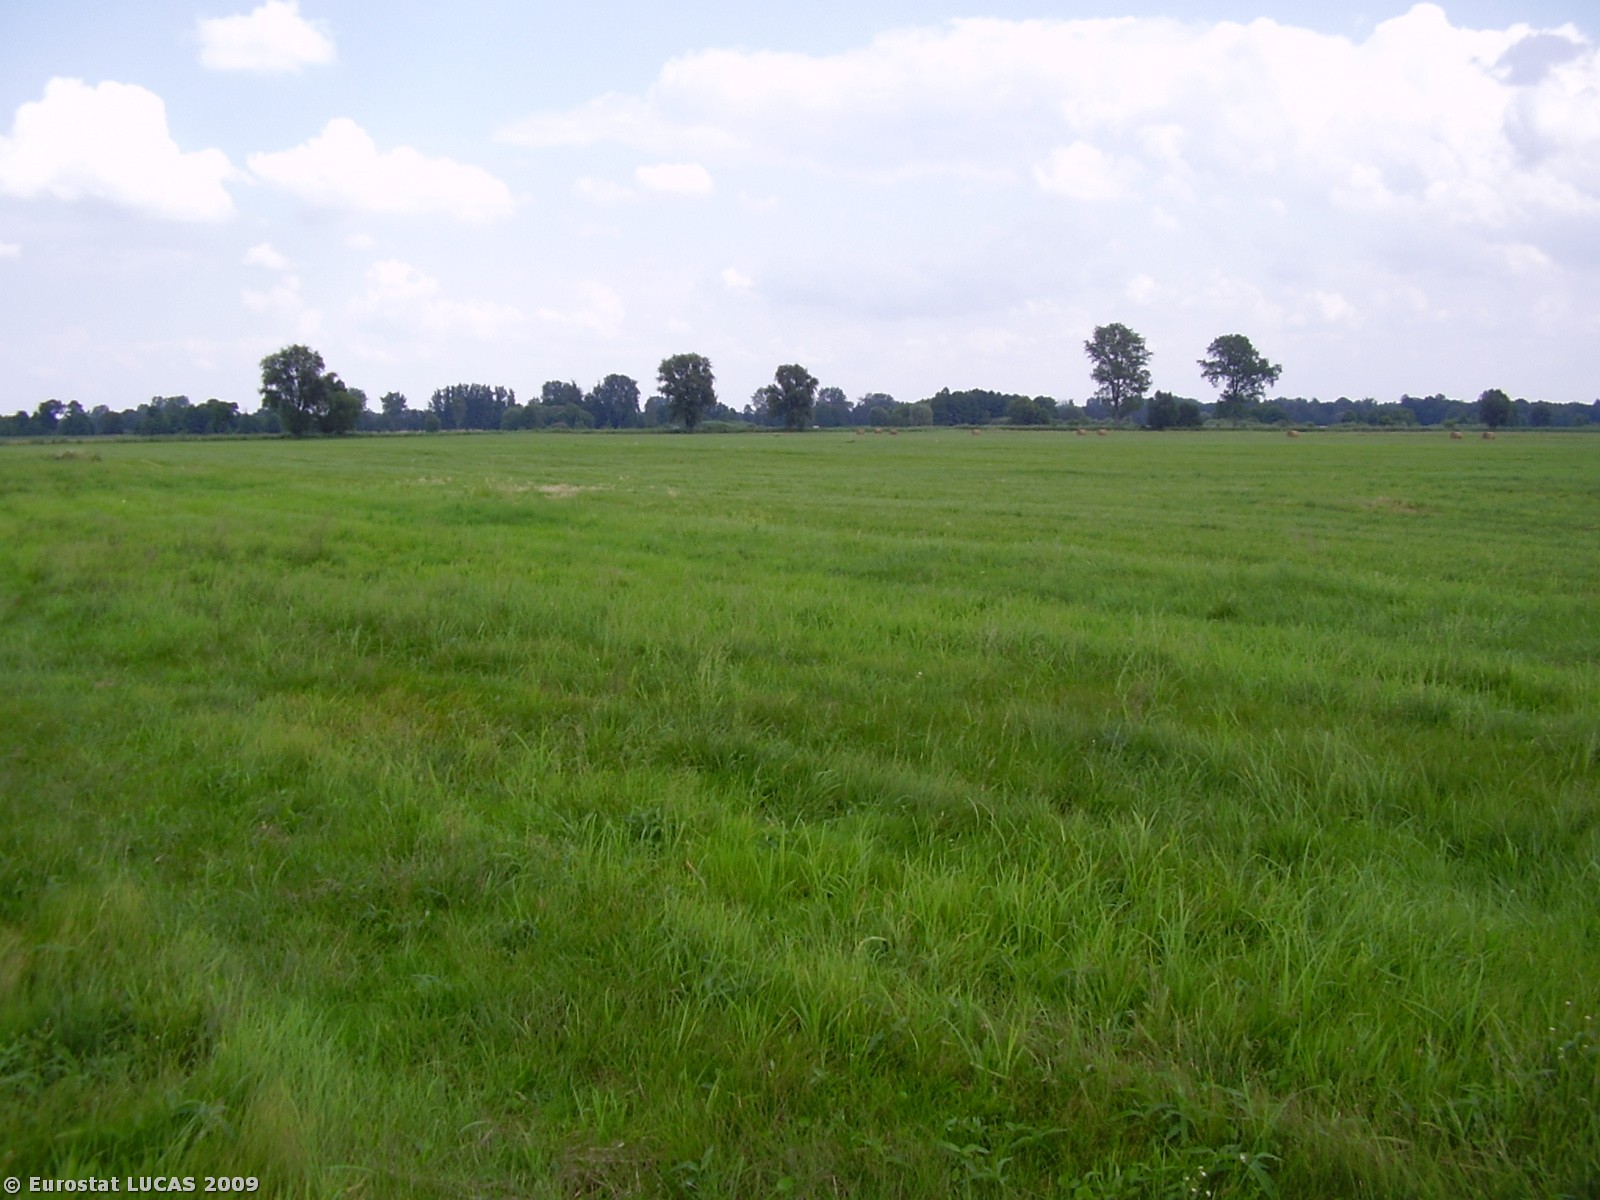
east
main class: Grassland
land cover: Grassland without tree/shrub cover
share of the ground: > 75 %
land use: Agriculture (excluding fallow land and kitchen gardens)
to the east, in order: Grassland without tree/shrub cover
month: July
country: PL
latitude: 52.0304
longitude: 16.2889
